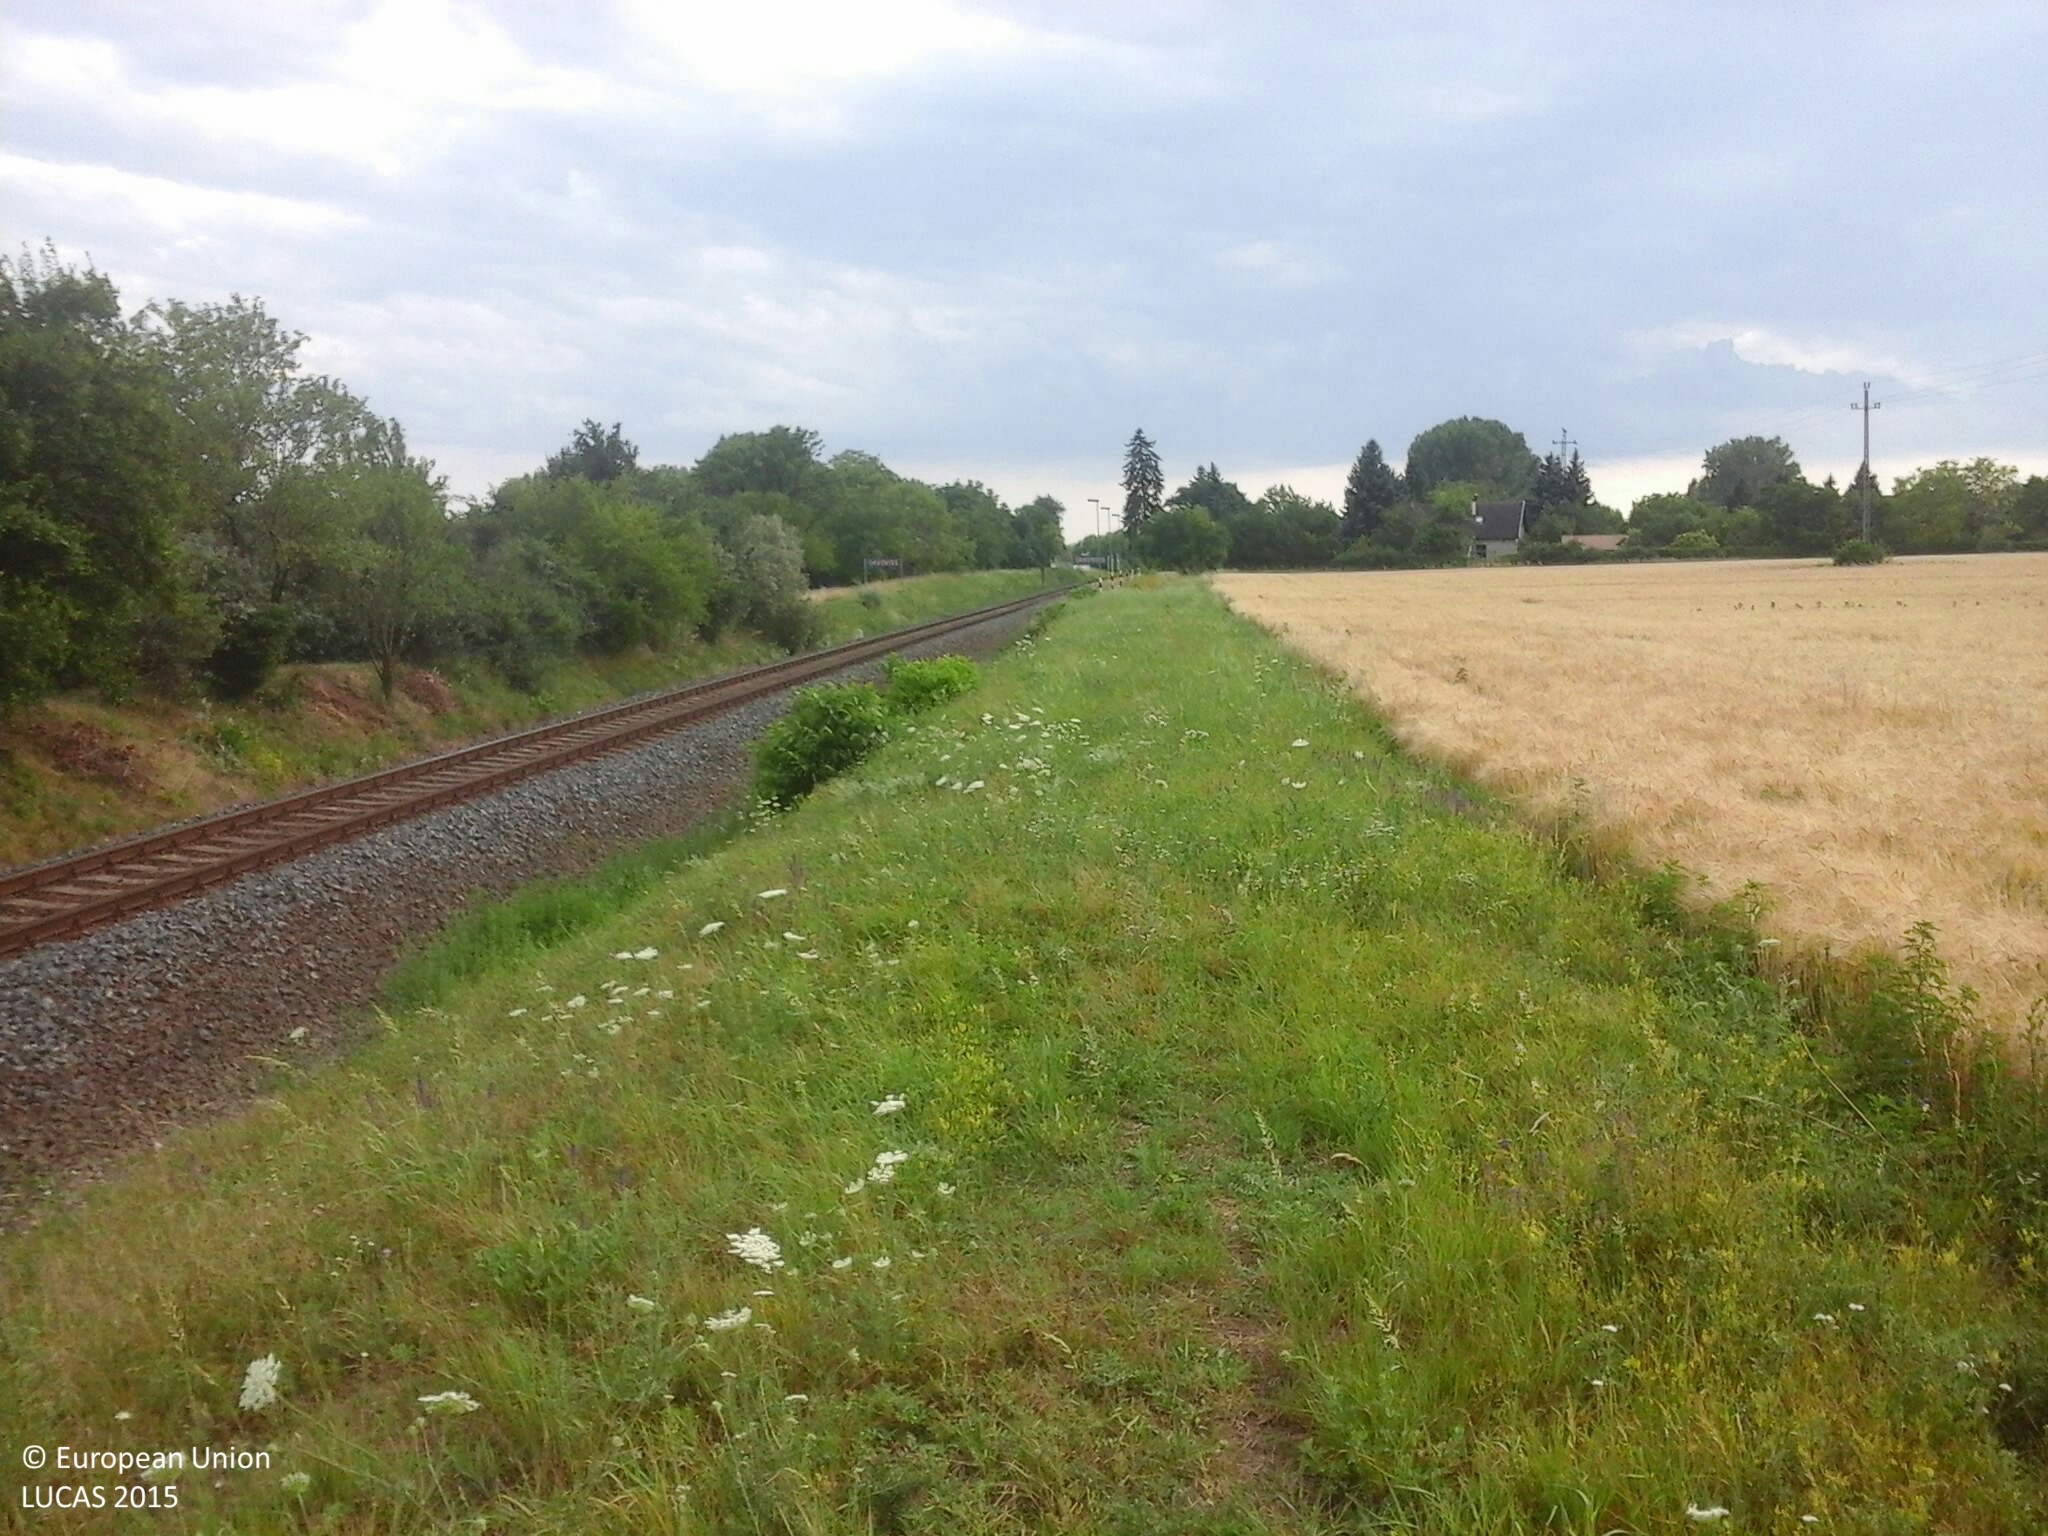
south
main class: Grassland
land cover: Grassland without tree/shrub cover
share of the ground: > 75 %
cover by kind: herbaceous plants 100 %
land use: Agriculture (excluding fallow land and kitchen gardens)
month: July
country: HU
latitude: 46.9148
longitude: 17.8204
